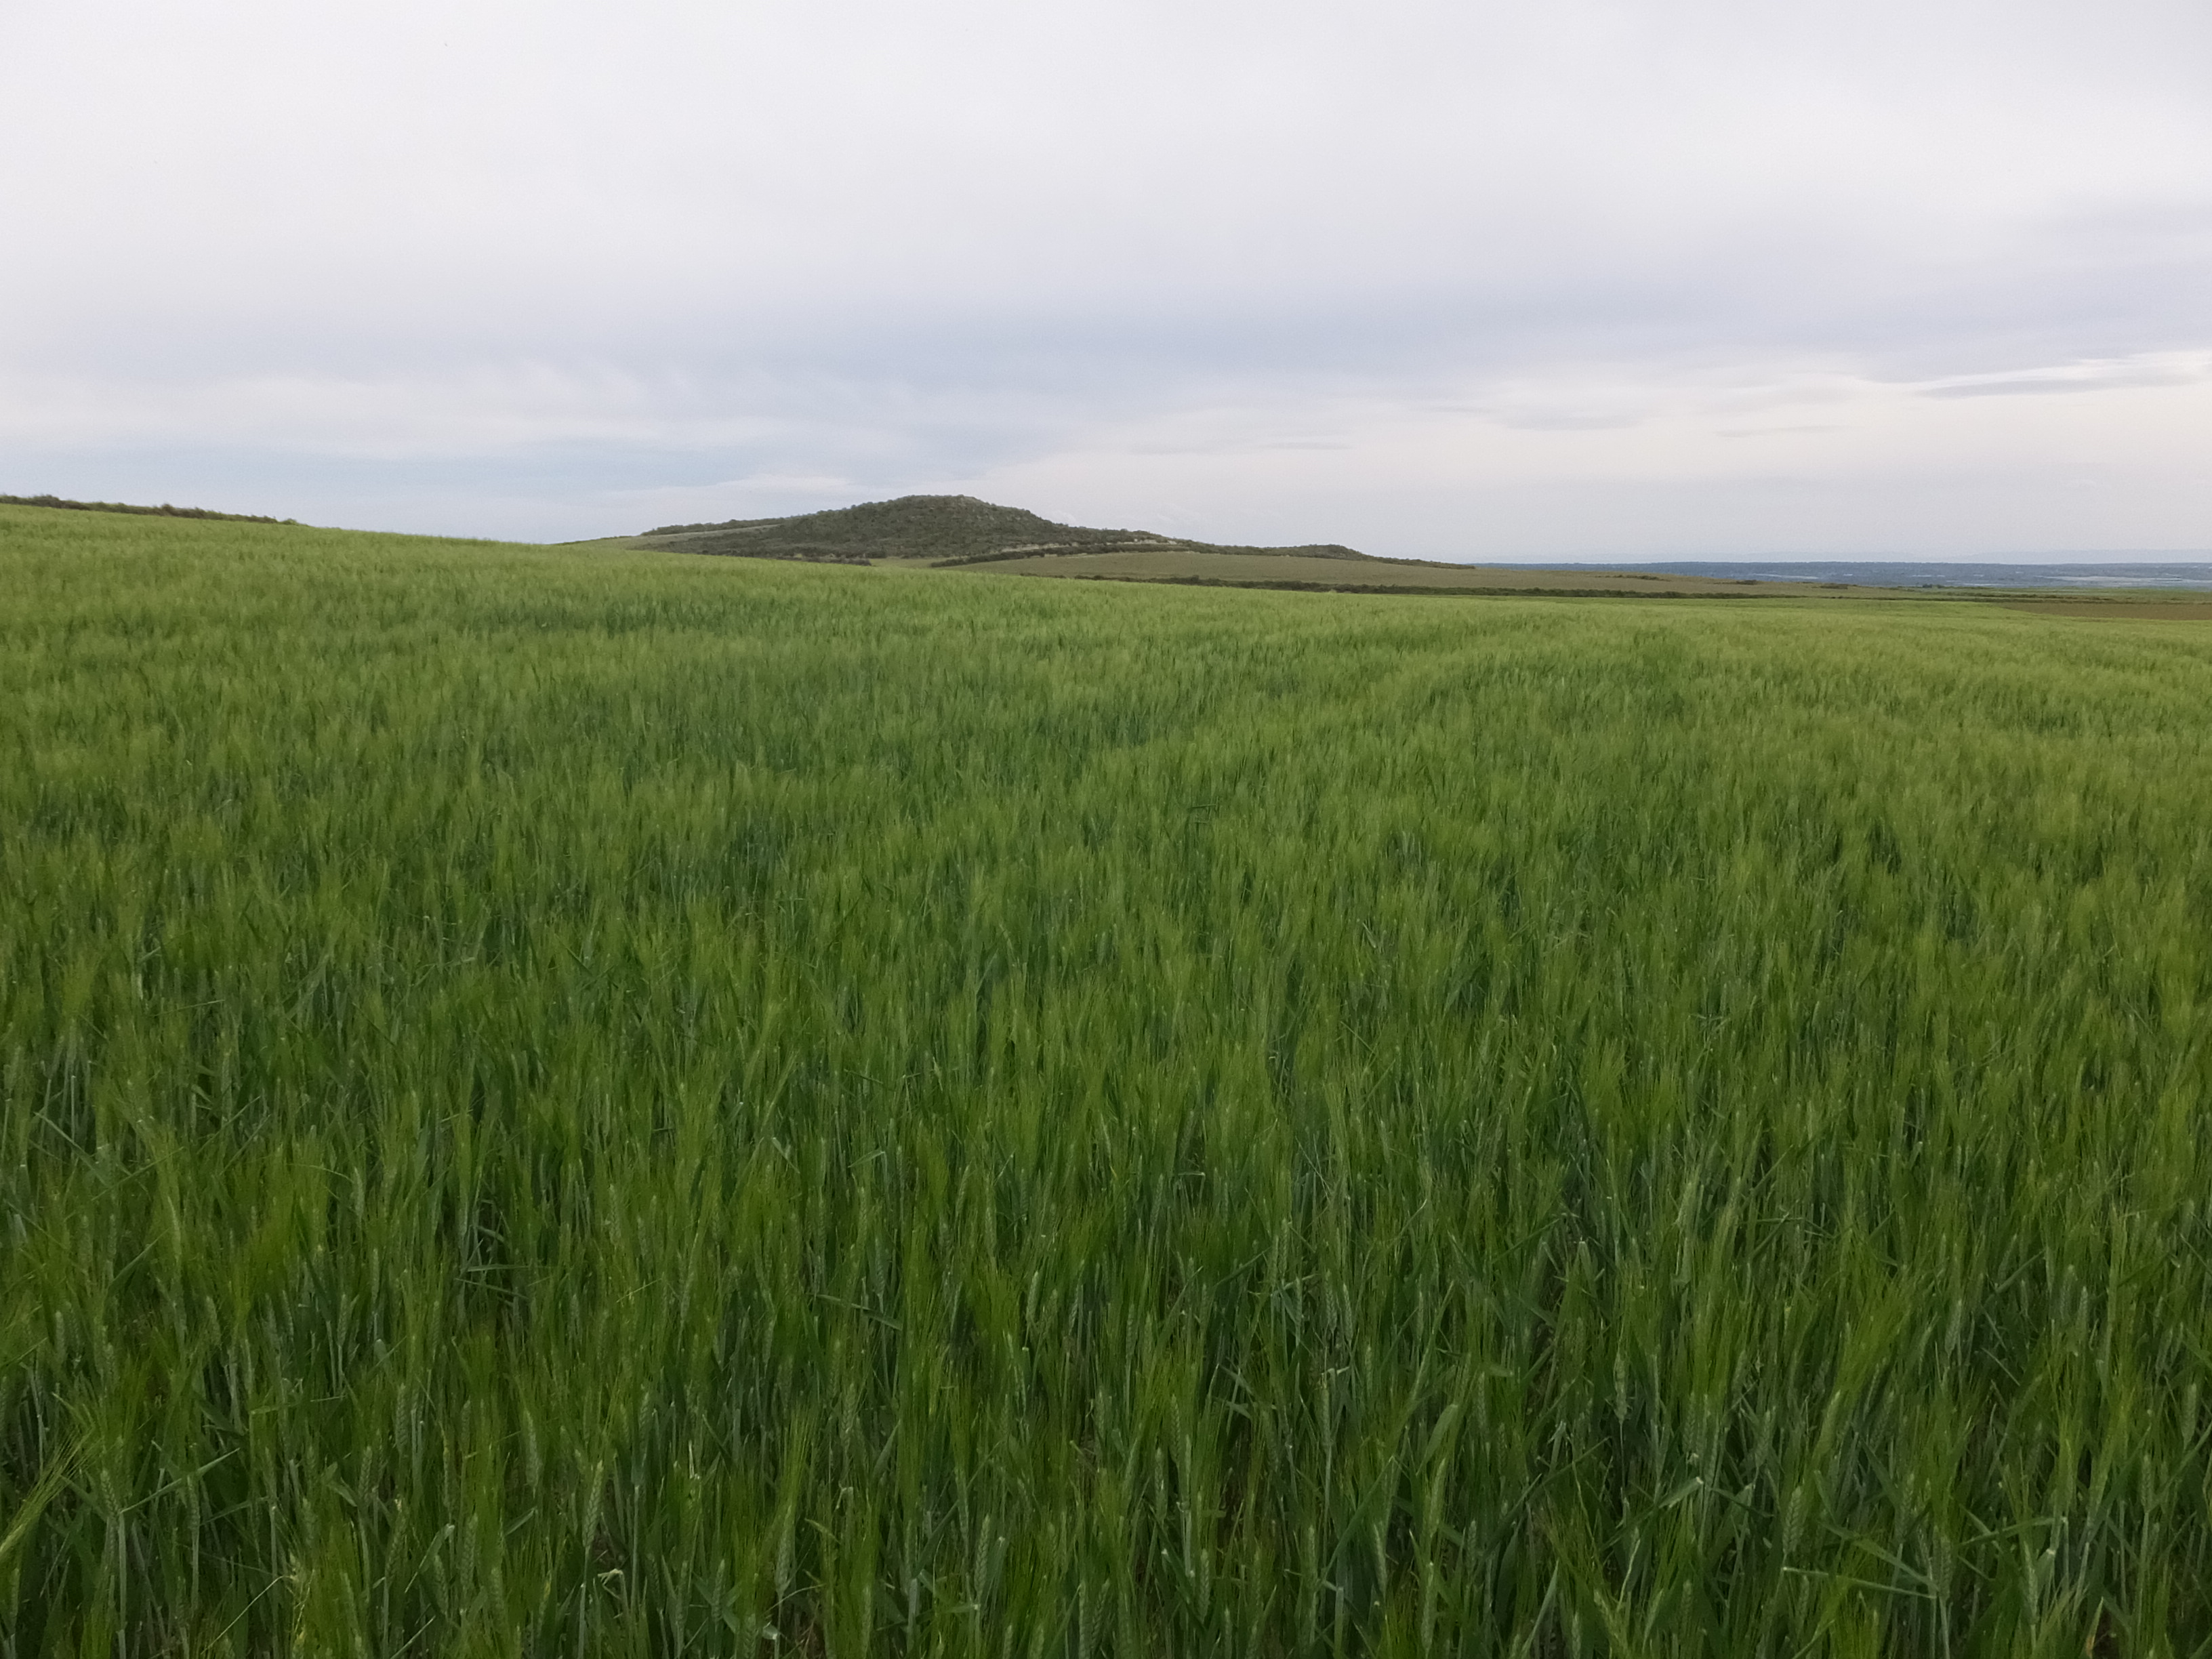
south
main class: Cropland
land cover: Durum wheat
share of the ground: > 75 %
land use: Agriculture (excluding fallow land and kitchen gardens)
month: April
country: ES
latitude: 41.5511
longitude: -0.2430
